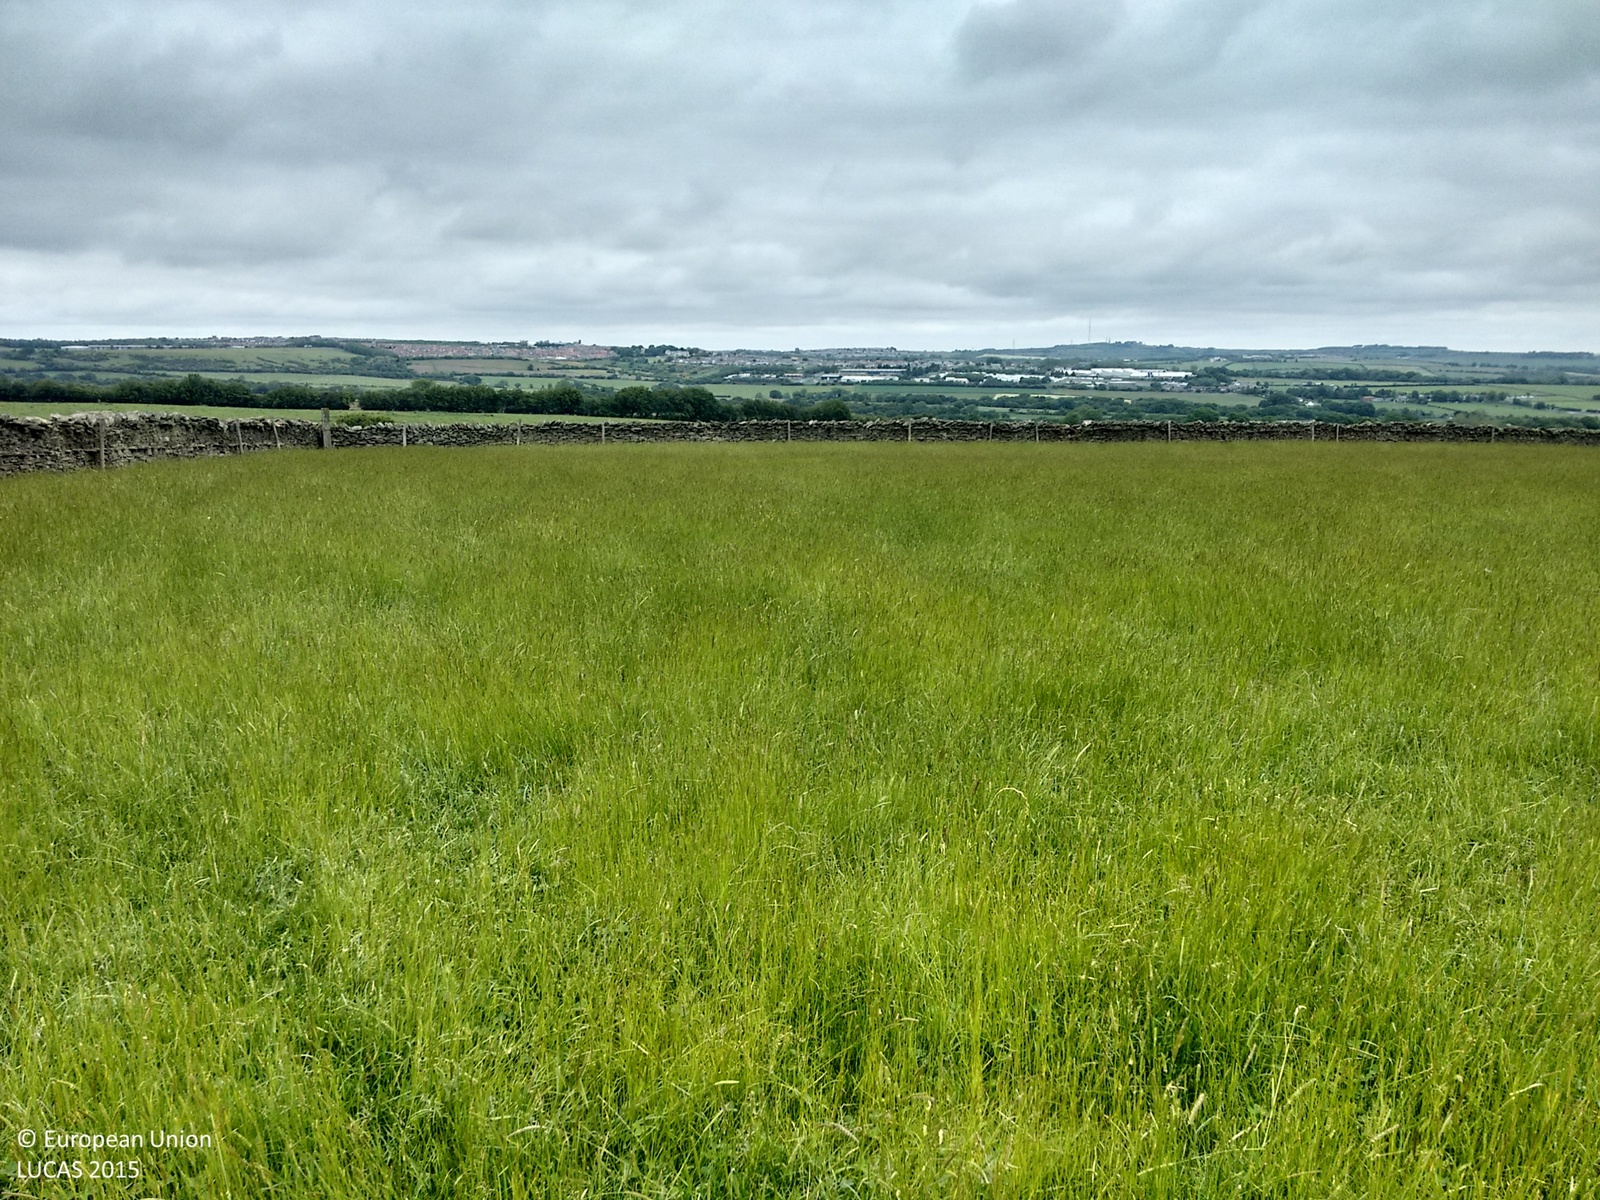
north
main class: Grassland
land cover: Grassland without tree/shrub cover
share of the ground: > 75 %
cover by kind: herbaceous plants 100 %
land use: Agriculture (excluding fallow land and kitchen gardens)
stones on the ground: < 10 %
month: June
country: GB
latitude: 54.8194
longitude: -1.8338
